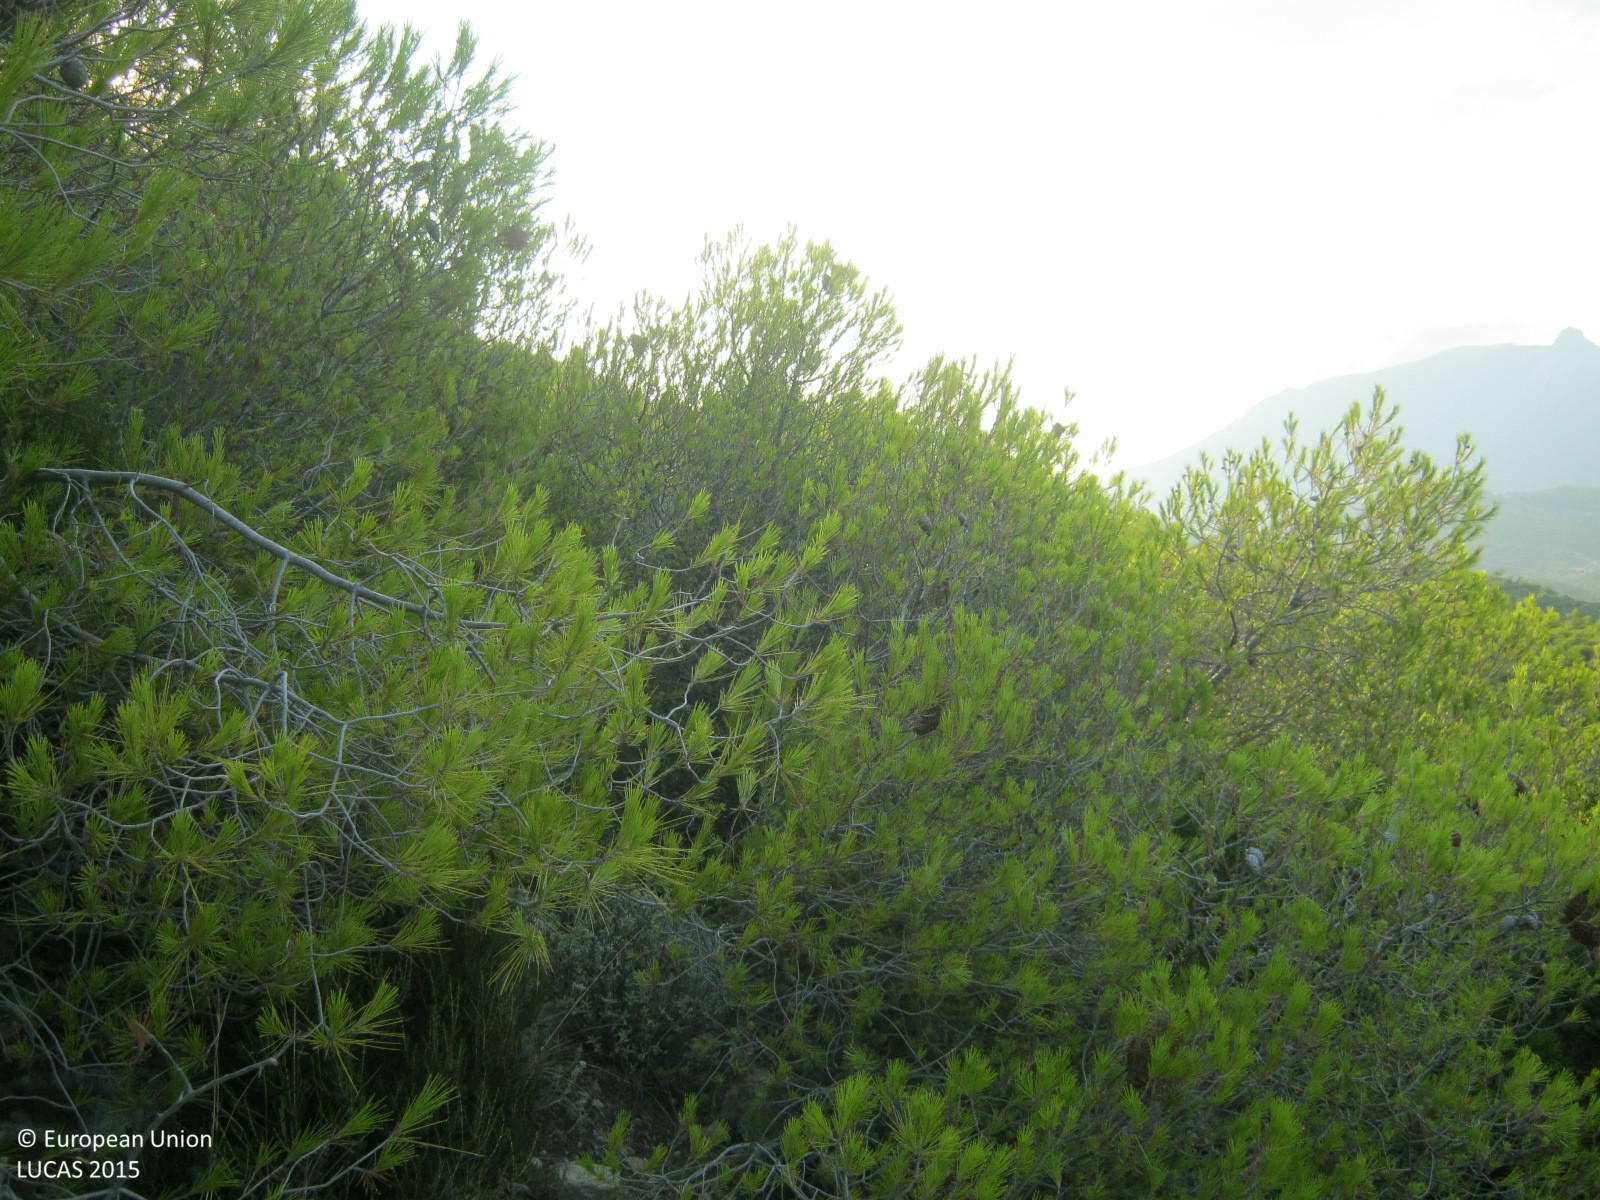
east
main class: Woodland
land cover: Pine dominated coniferous woodland
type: coniferous forest of the mediterranean region
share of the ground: 50 - 75 %
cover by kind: coniferous forest trees 65 %, unconsolidated bare surface 25 %, shrubs 5 %, herbaceous plants 5 %
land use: Semi-natural and natural areas not in use
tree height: < 5 m
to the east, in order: Pine dominated coniferous woodland; Rocks and stones; Pine dominated coniferous woodland
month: July
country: GR
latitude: 38.0376
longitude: 22.9053
